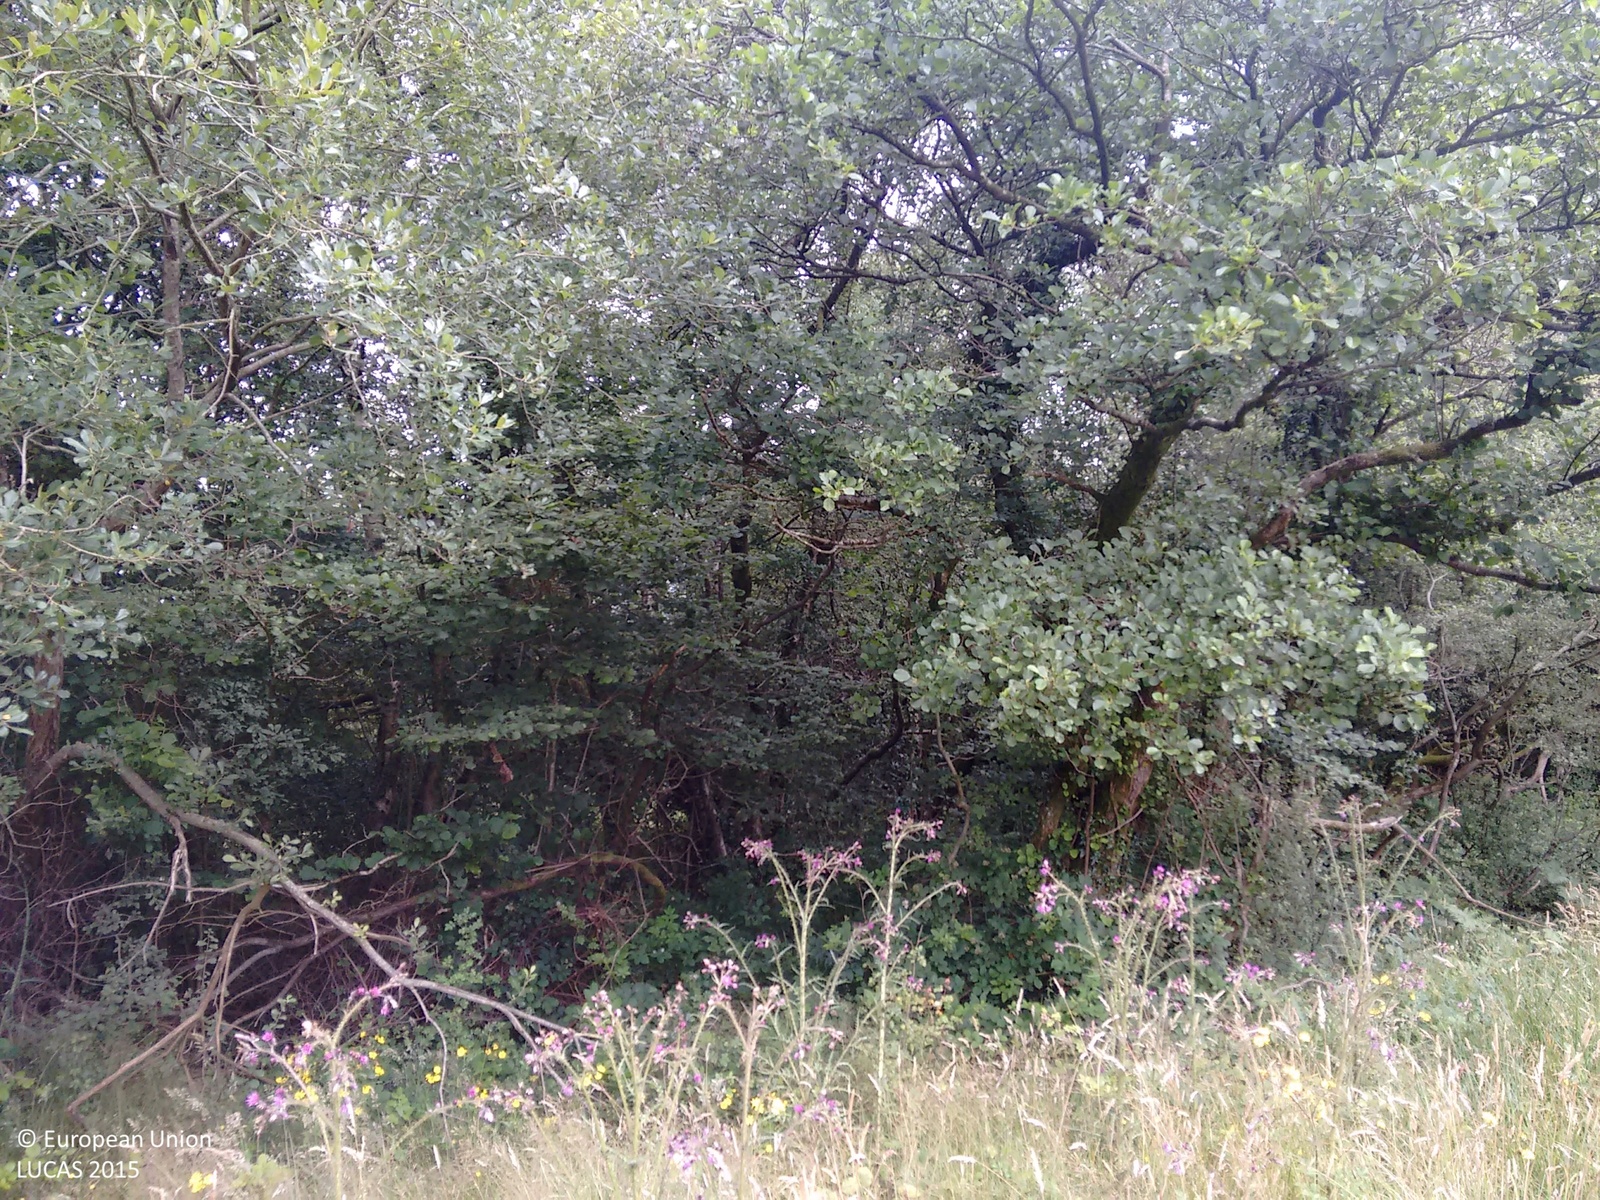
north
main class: Grassland
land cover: Grassland without tree/shrub cover
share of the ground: > 75 %
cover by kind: herbaceous plants 100 %
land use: Agriculture (excluding fallow land and kitchen gardens)
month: July
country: GB
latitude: 51.7734
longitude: -4.0521
